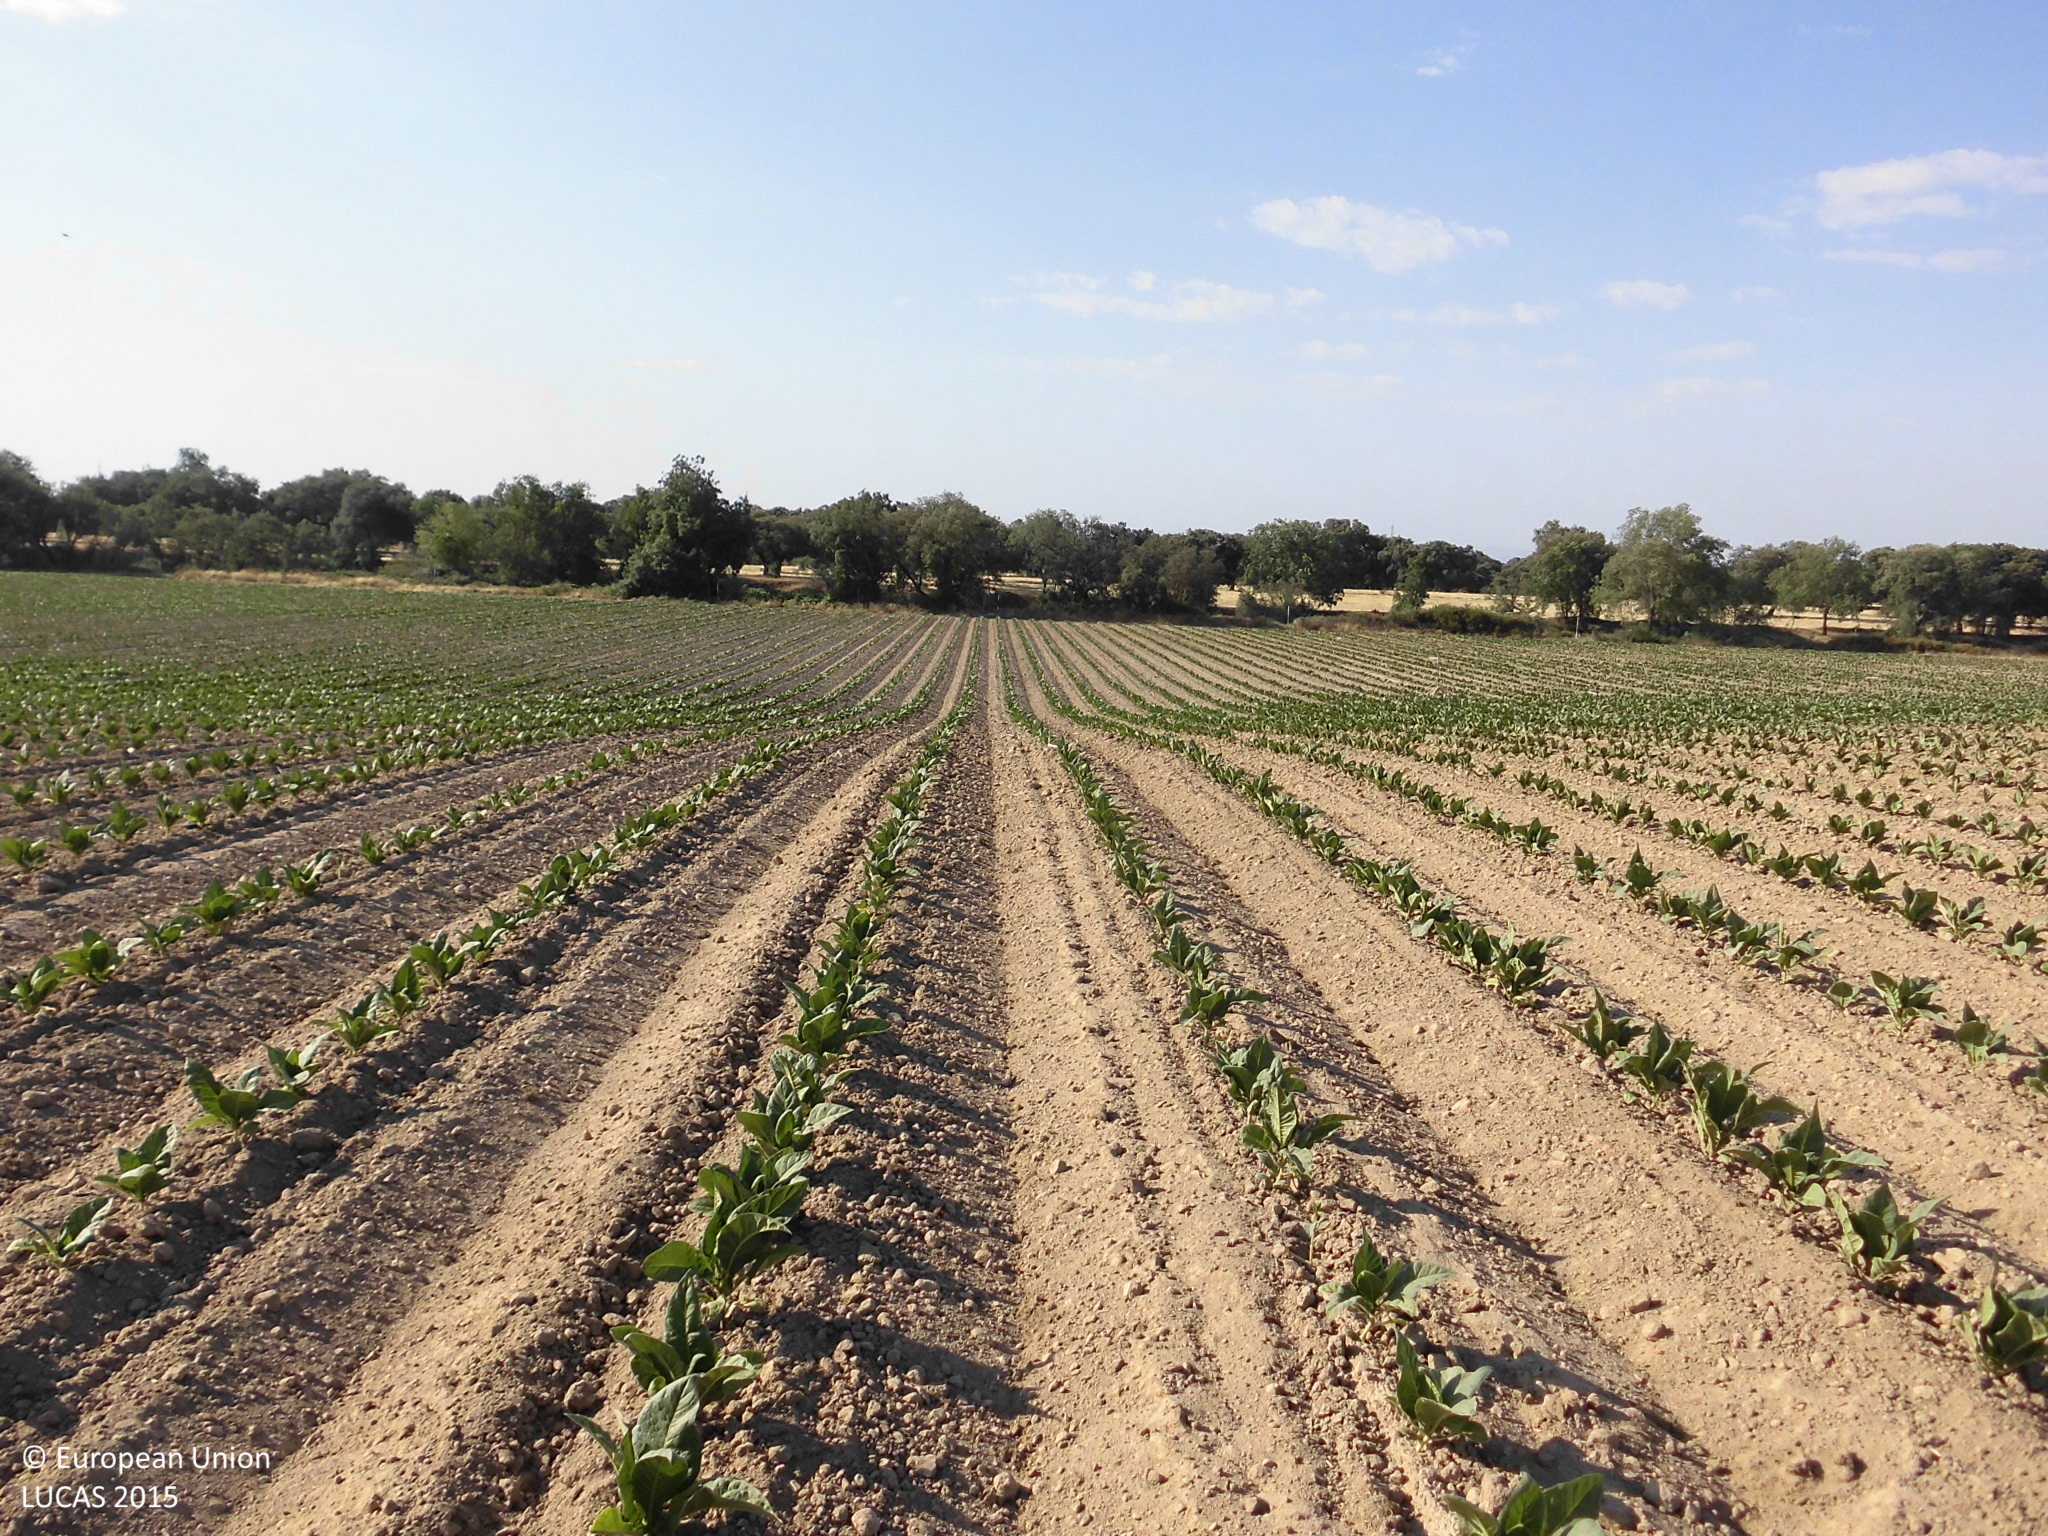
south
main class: Cropland
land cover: Tobacco
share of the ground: 10 - 25 %
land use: Agriculture (excluding fallow land and kitchen gardens)
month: June
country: ES
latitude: 39.9718
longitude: -5.4552
